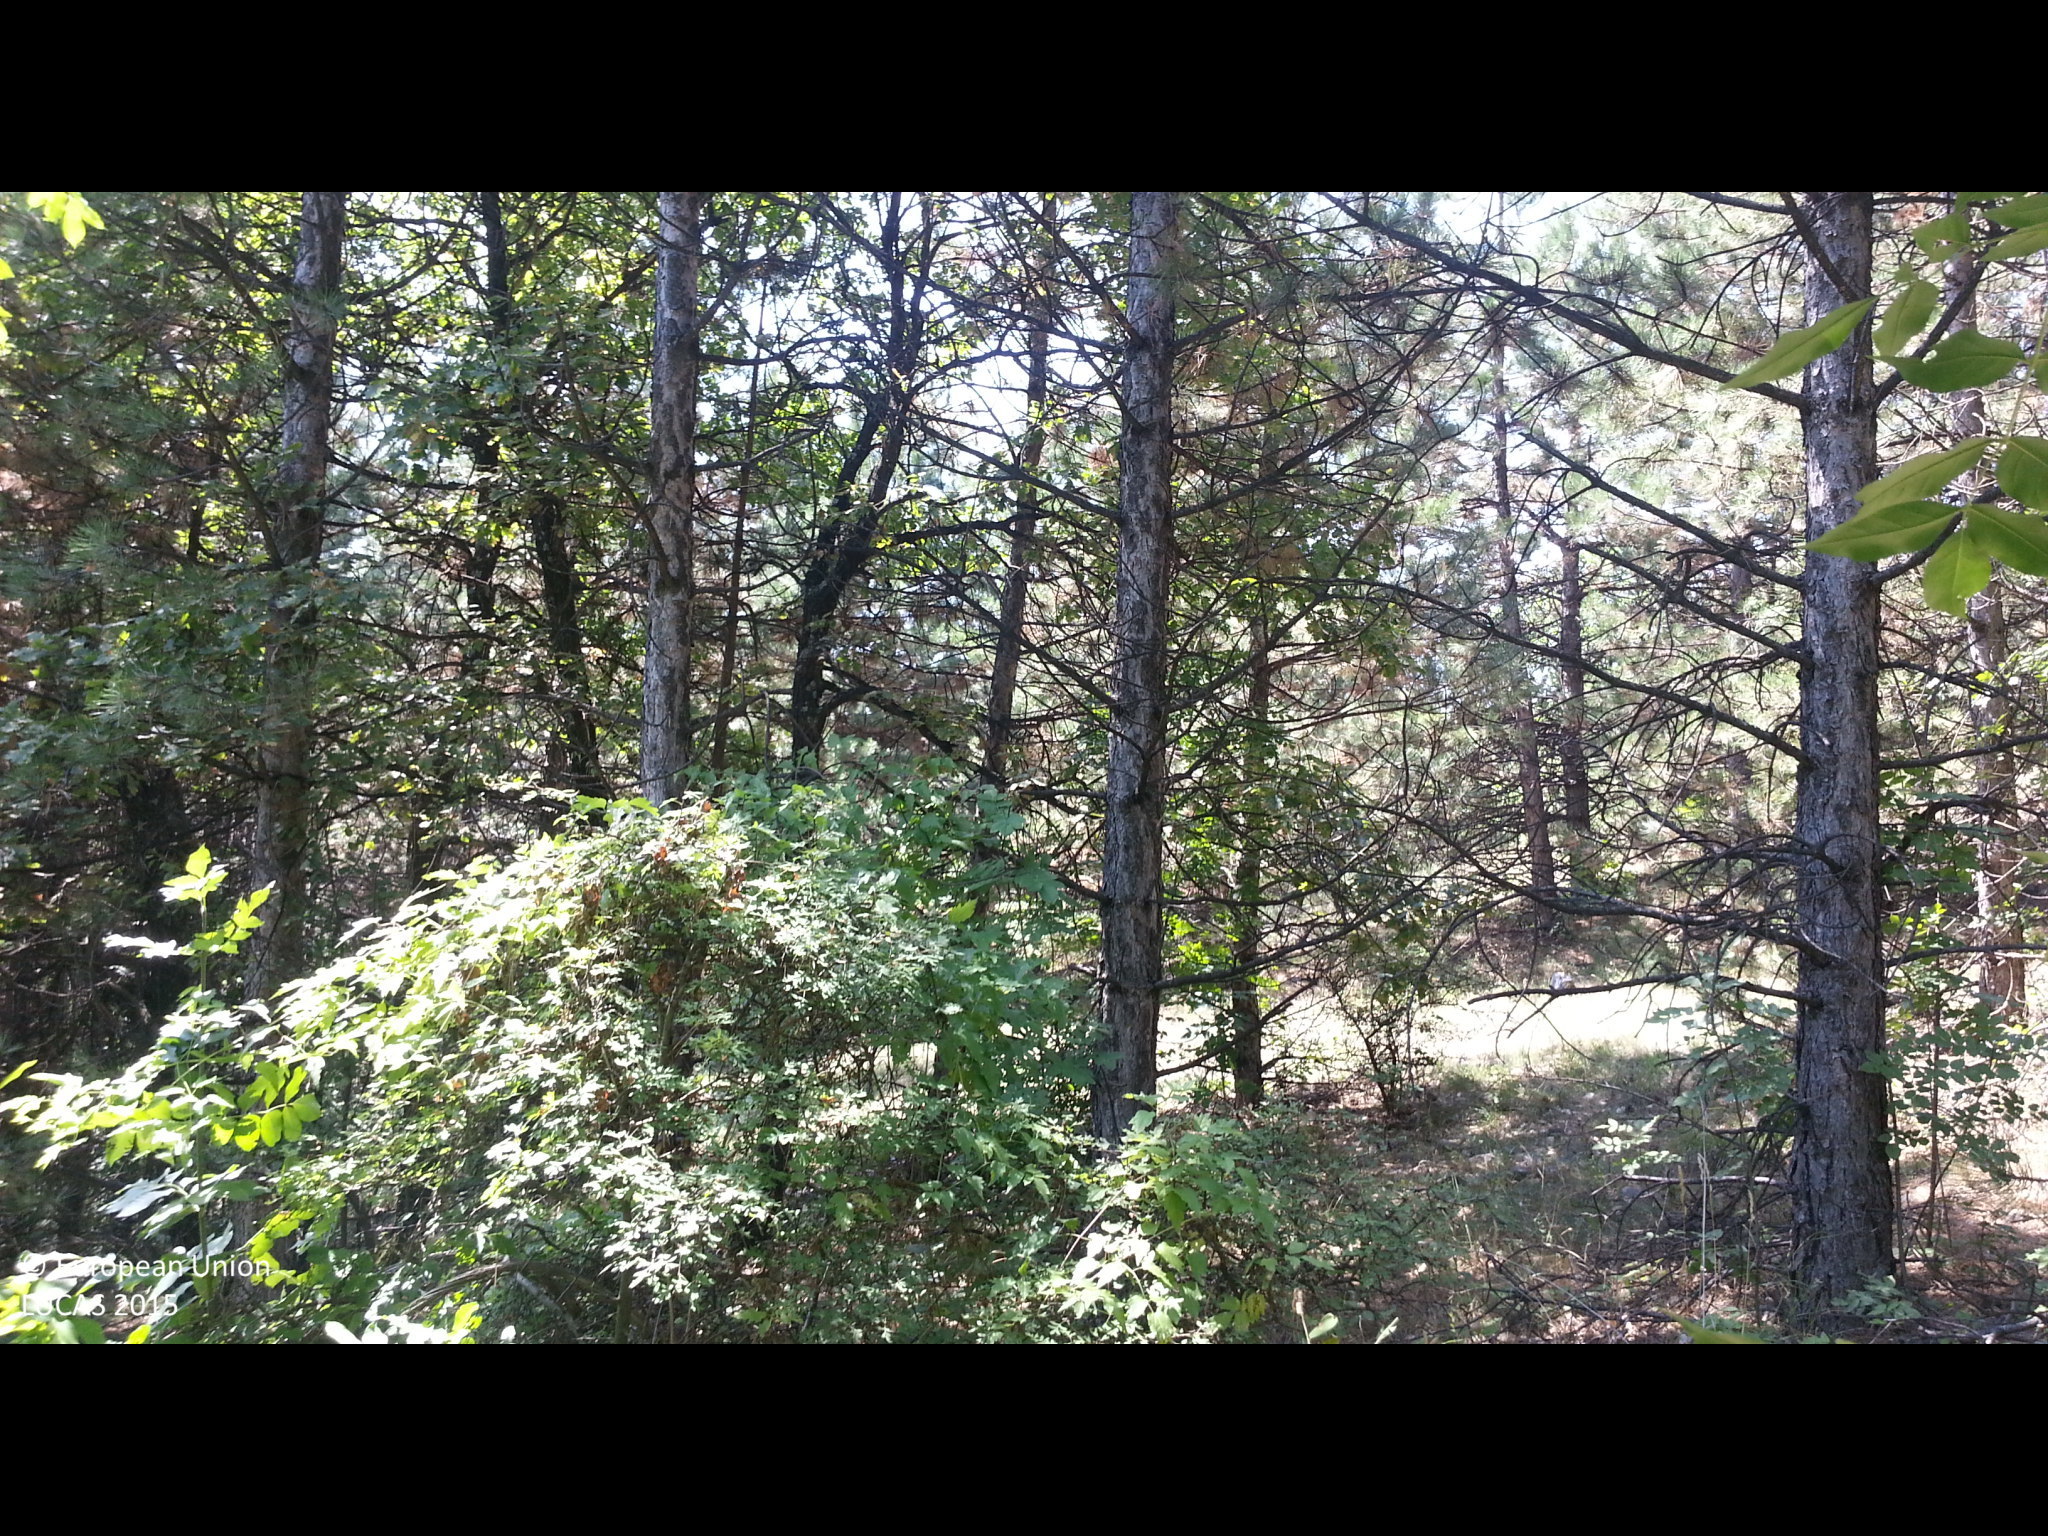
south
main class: Woodland
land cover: Pine dominated mixed woodland
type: hemiboreal forest and nemoral coniferous forest and mixed broadleaved-coniferous forest
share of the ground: > 75 %
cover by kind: coniferous forest trees 75 %, broadleaved forest trees 25 %
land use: Forestry
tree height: > 5 m
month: August
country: BG
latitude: 42.5278
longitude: 23.1167
